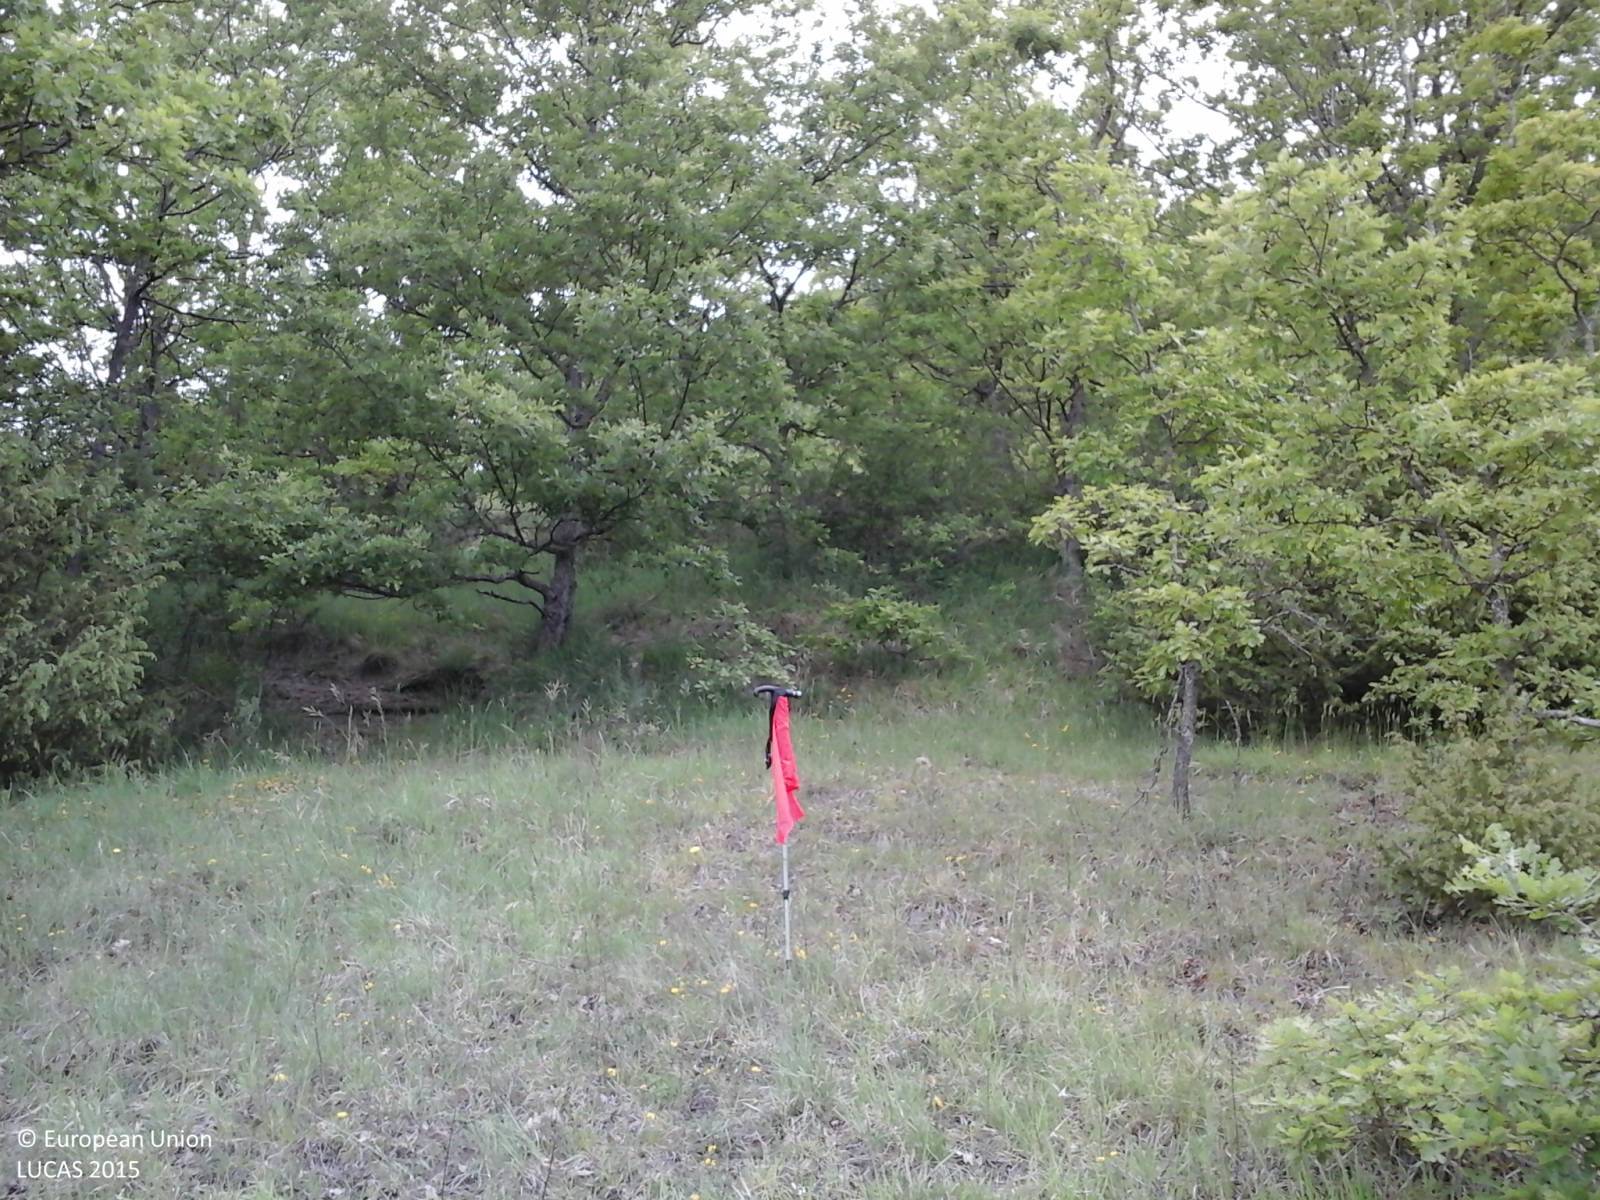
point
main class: Woodland
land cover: Broadleaved woodland
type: thermophilous deciduous forest
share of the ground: 10 - 25 %
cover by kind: herbaceous plants 80 %, broadleaved forest trees 10 %, shrubs 10 %
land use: Agriculture (excluding fallow land and kitchen gardens)
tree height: < 5 m
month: May
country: IT
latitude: 41.8439
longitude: 14.1889
